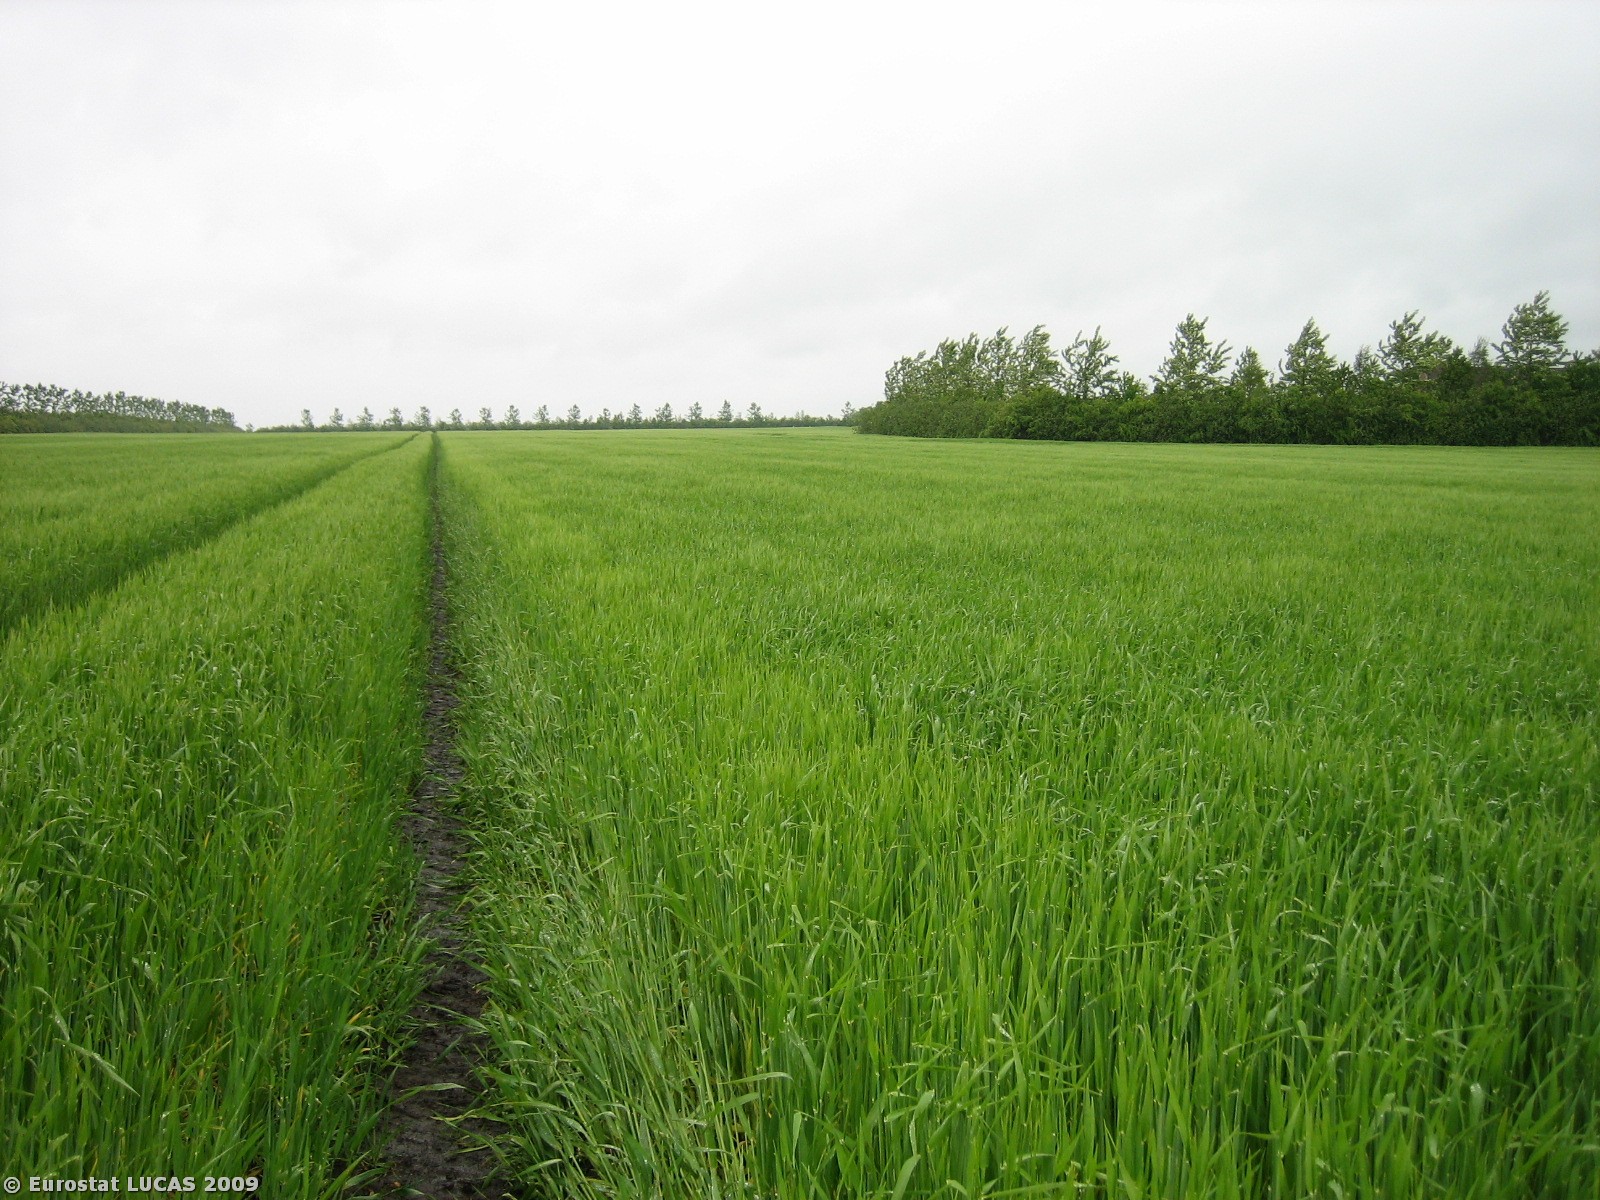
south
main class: Cropland
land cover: Barley
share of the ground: > 75 %
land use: Agriculture (excluding fallow land and kitchen gardens)
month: May
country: DK
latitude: 56.0532
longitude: 8.5083
